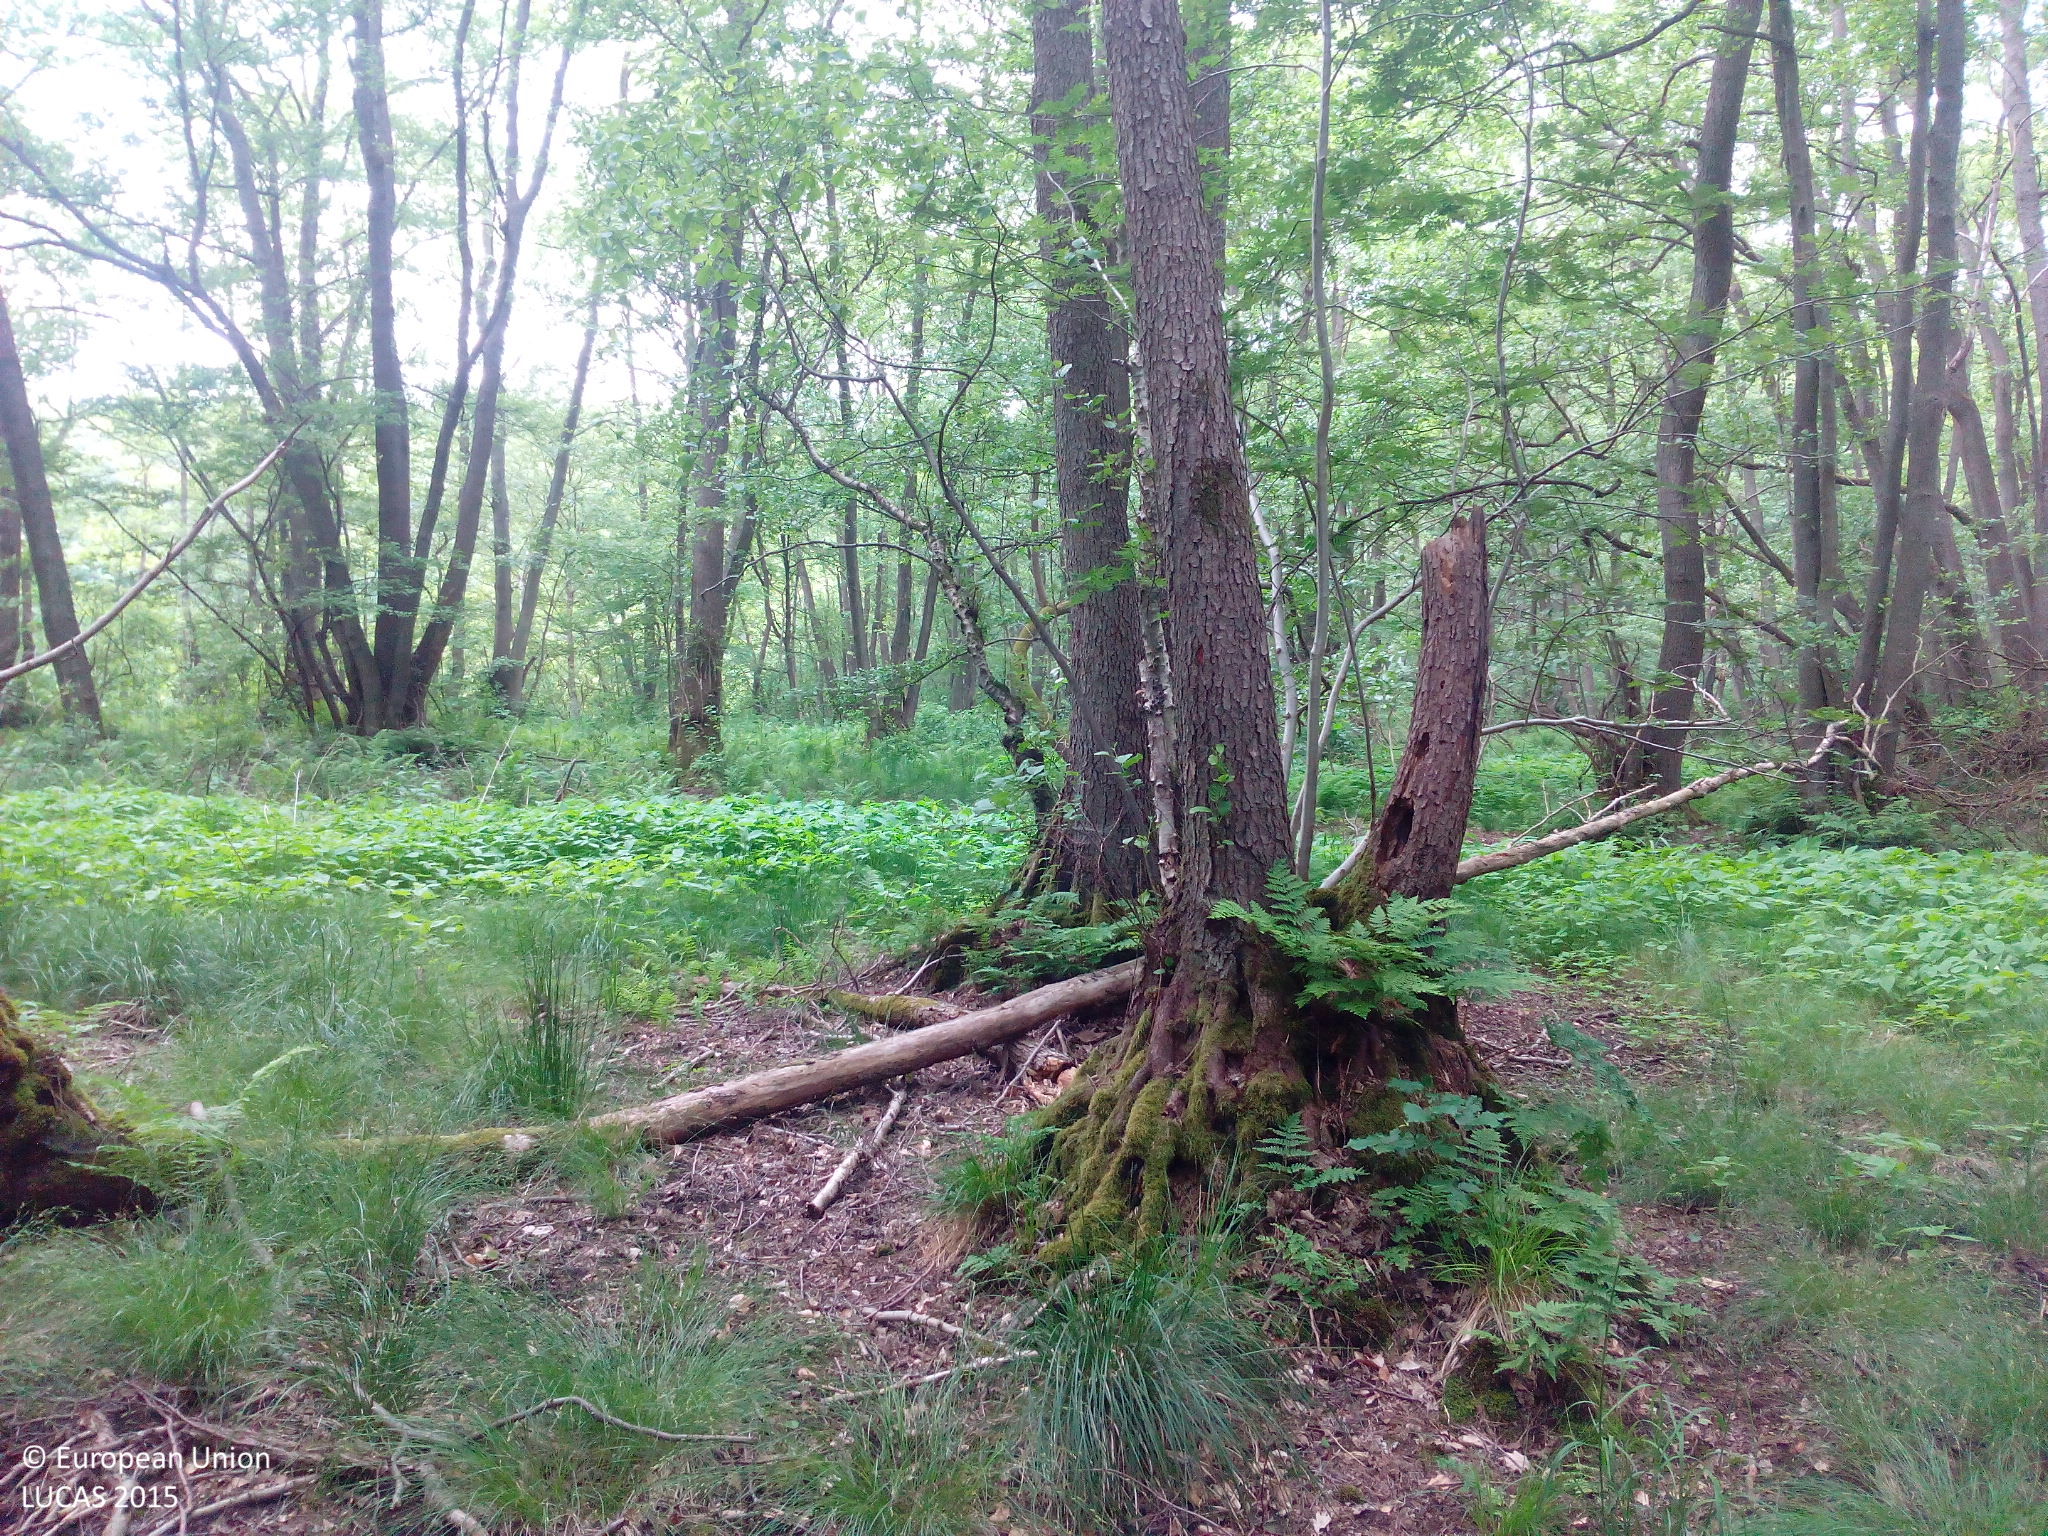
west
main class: Woodland
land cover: Broadleaved woodland
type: mesophytic deciduous forest
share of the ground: 50 - 75 %
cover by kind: broadleaved forest trees 60 %, herbaceous plants 20 %, unconsolidated bare surface 20 %
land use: Forestry
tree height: > 5 m
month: June
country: DE
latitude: 53.6604
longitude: 11.6487
